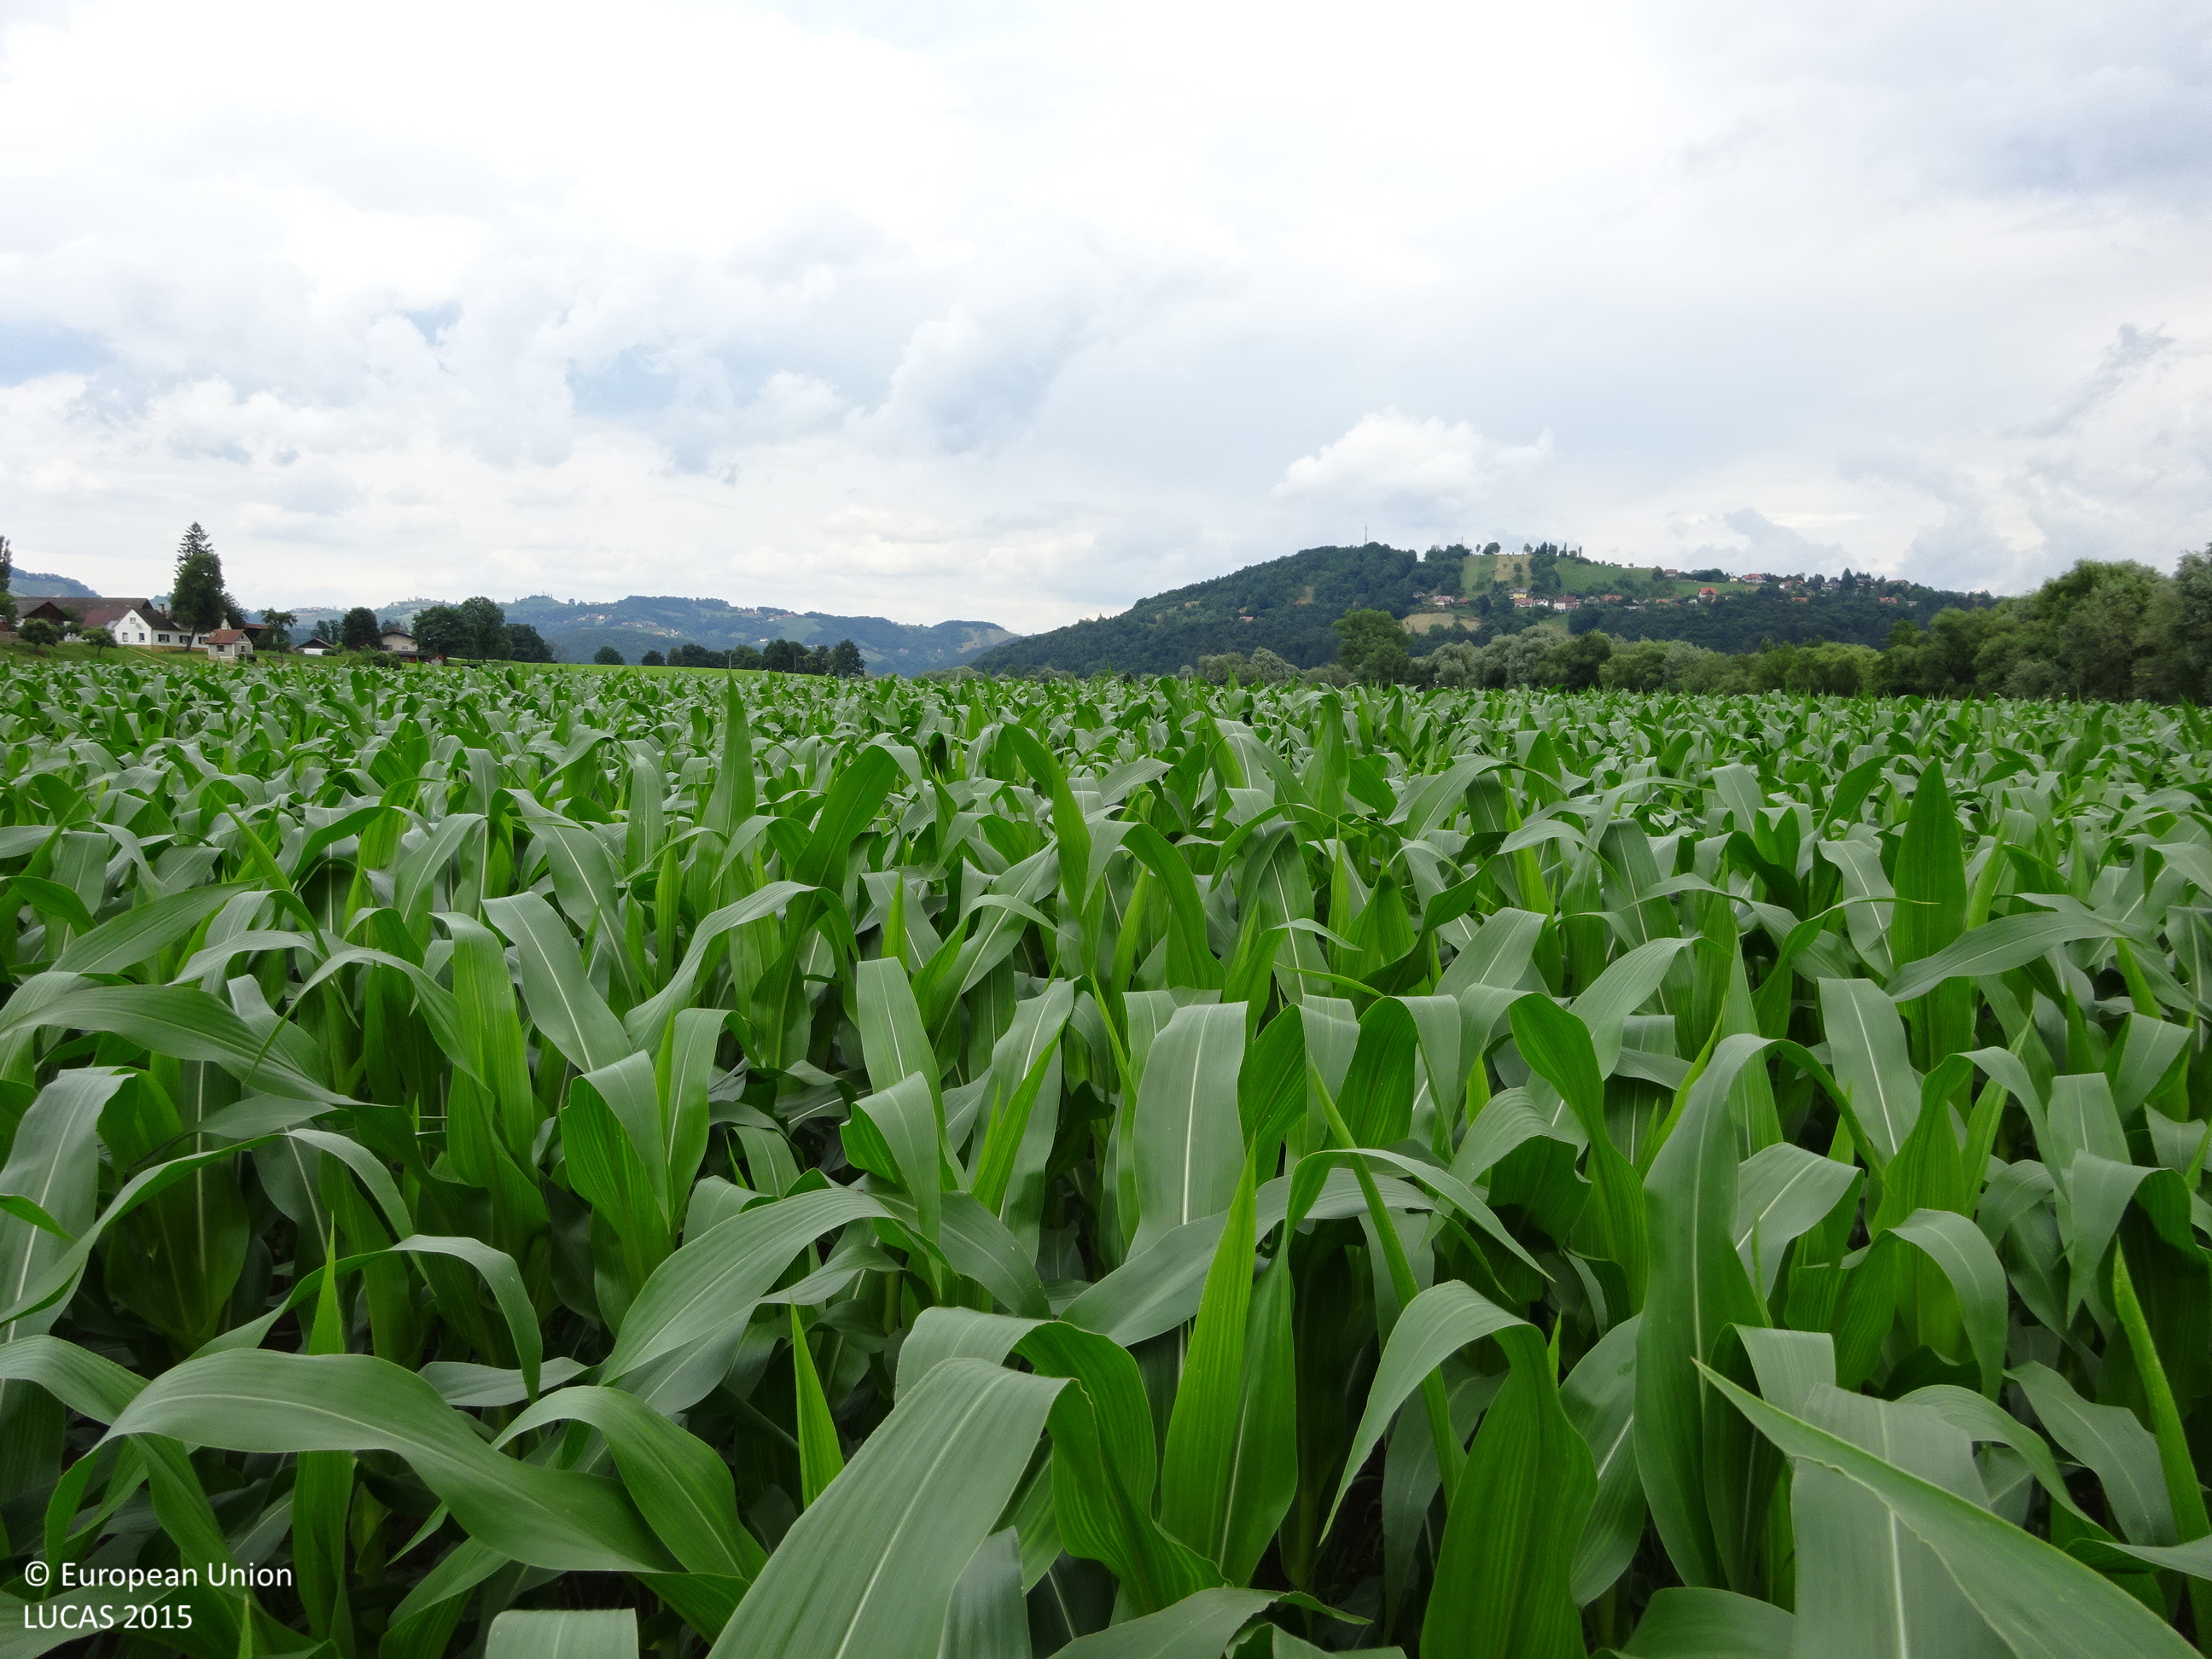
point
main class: Cropland
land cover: Maize
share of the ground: > 75 %
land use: Agriculture (excluding fallow land and kitchen gardens)
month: June
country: AT
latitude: 46.7367
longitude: 15.4302
